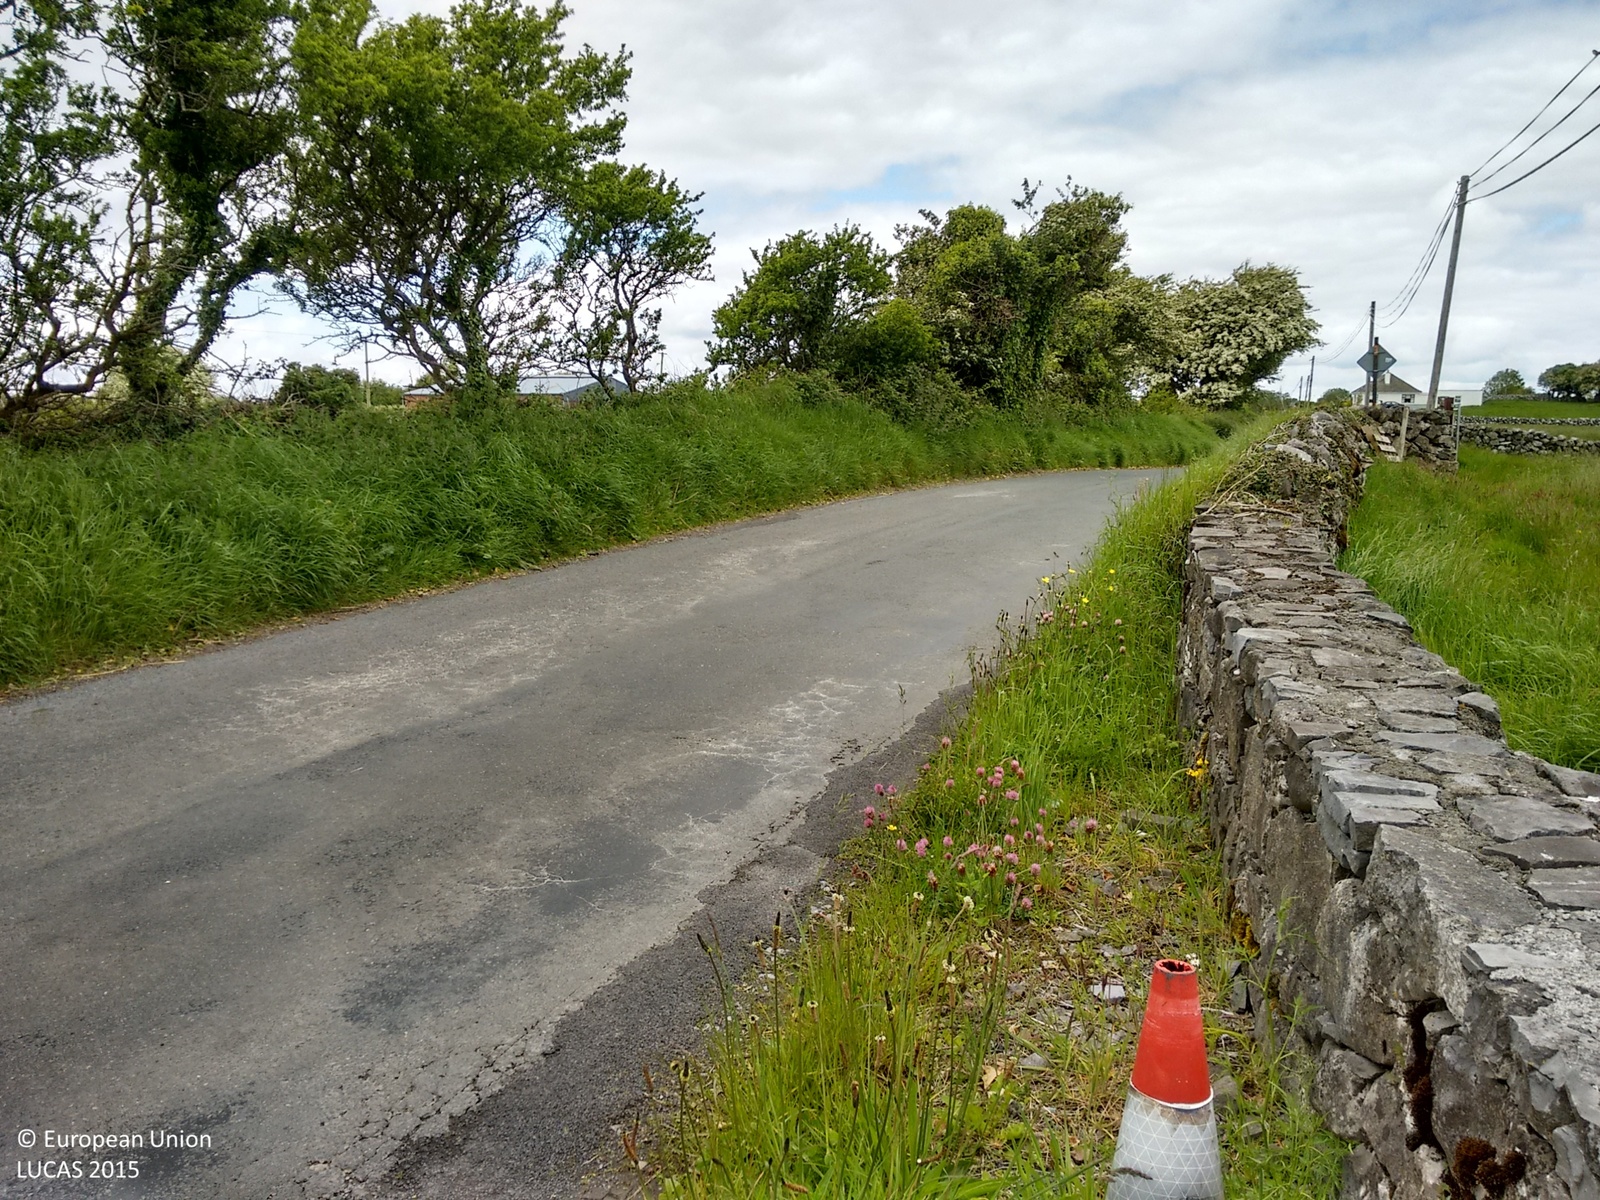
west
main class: Grassland
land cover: Grassland without tree/shrub cover
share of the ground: > 75 %
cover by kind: herbaceous plants 100 %
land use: Agriculture (excluding fallow land and kitchen gardens)
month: June
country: IE
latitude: 53.4594
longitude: -9.0560
